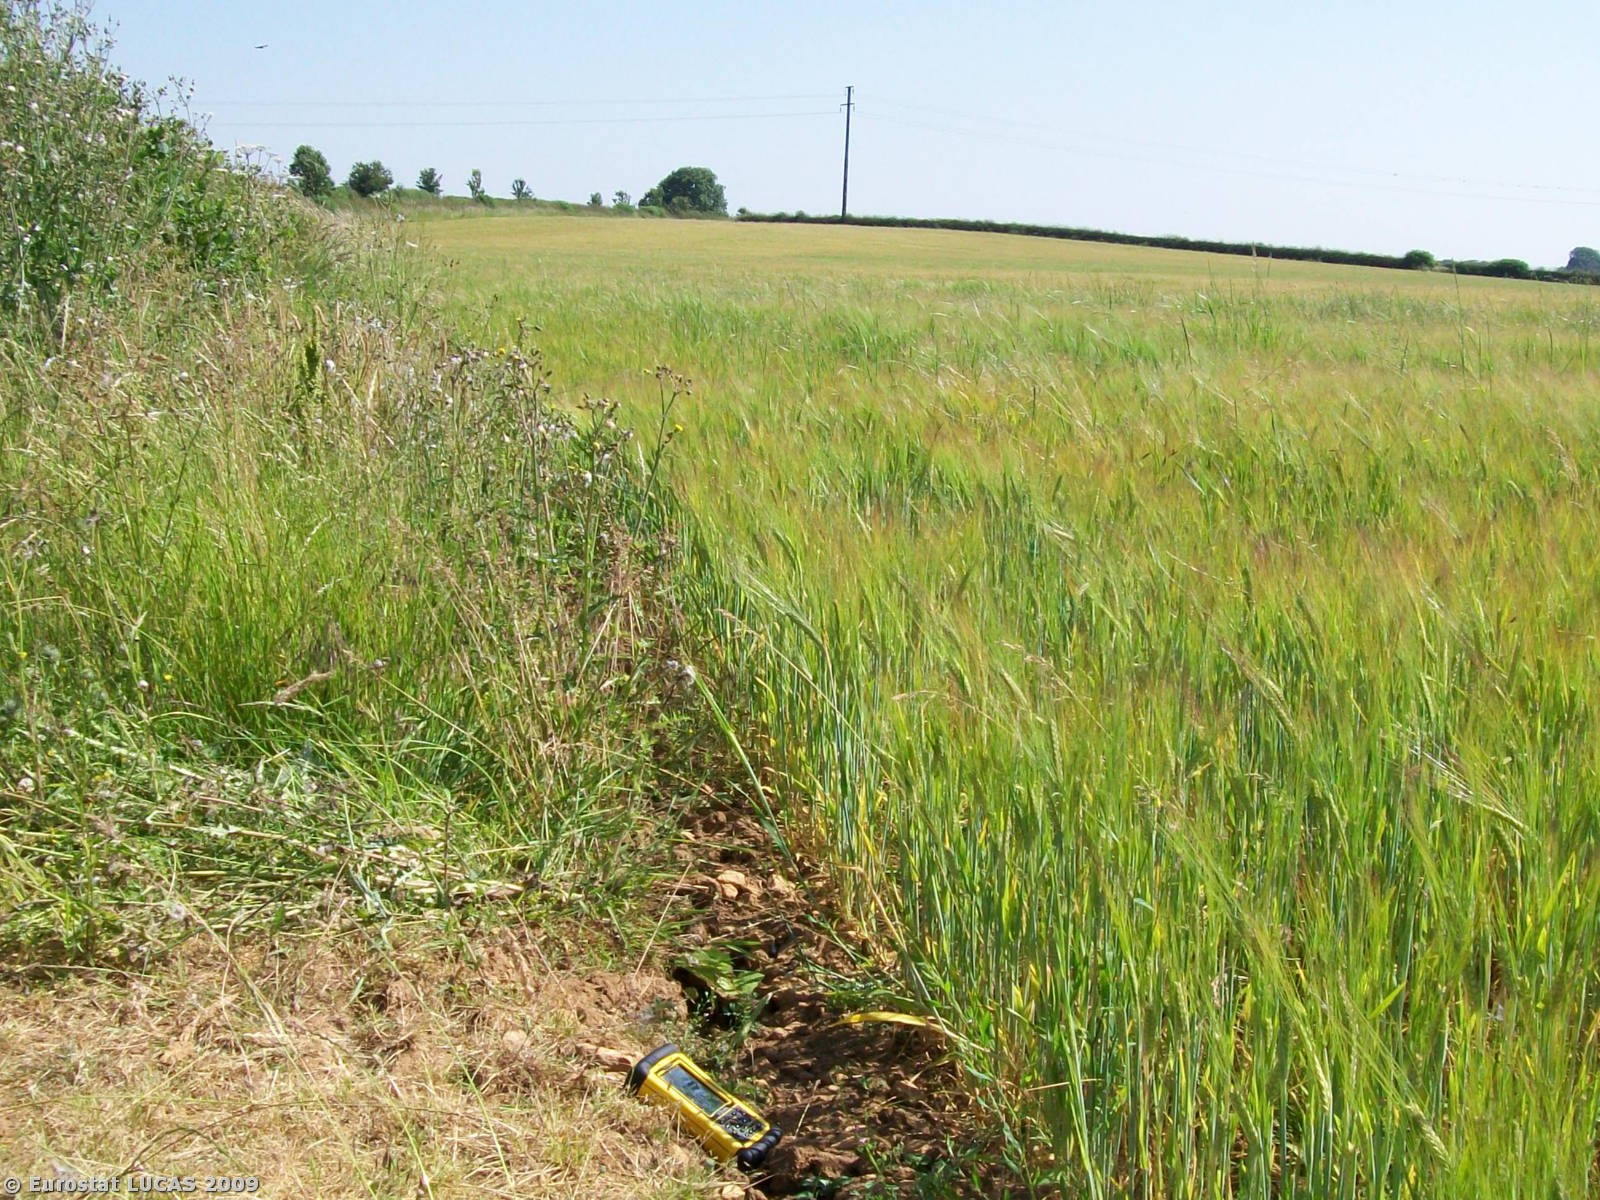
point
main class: Cropland
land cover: Barley
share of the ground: < 10 %
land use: Agriculture (excluding fallow land and kitchen gardens)
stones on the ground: 25 - 50 %
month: July
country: GB
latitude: 53.8955
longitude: -1.4159
